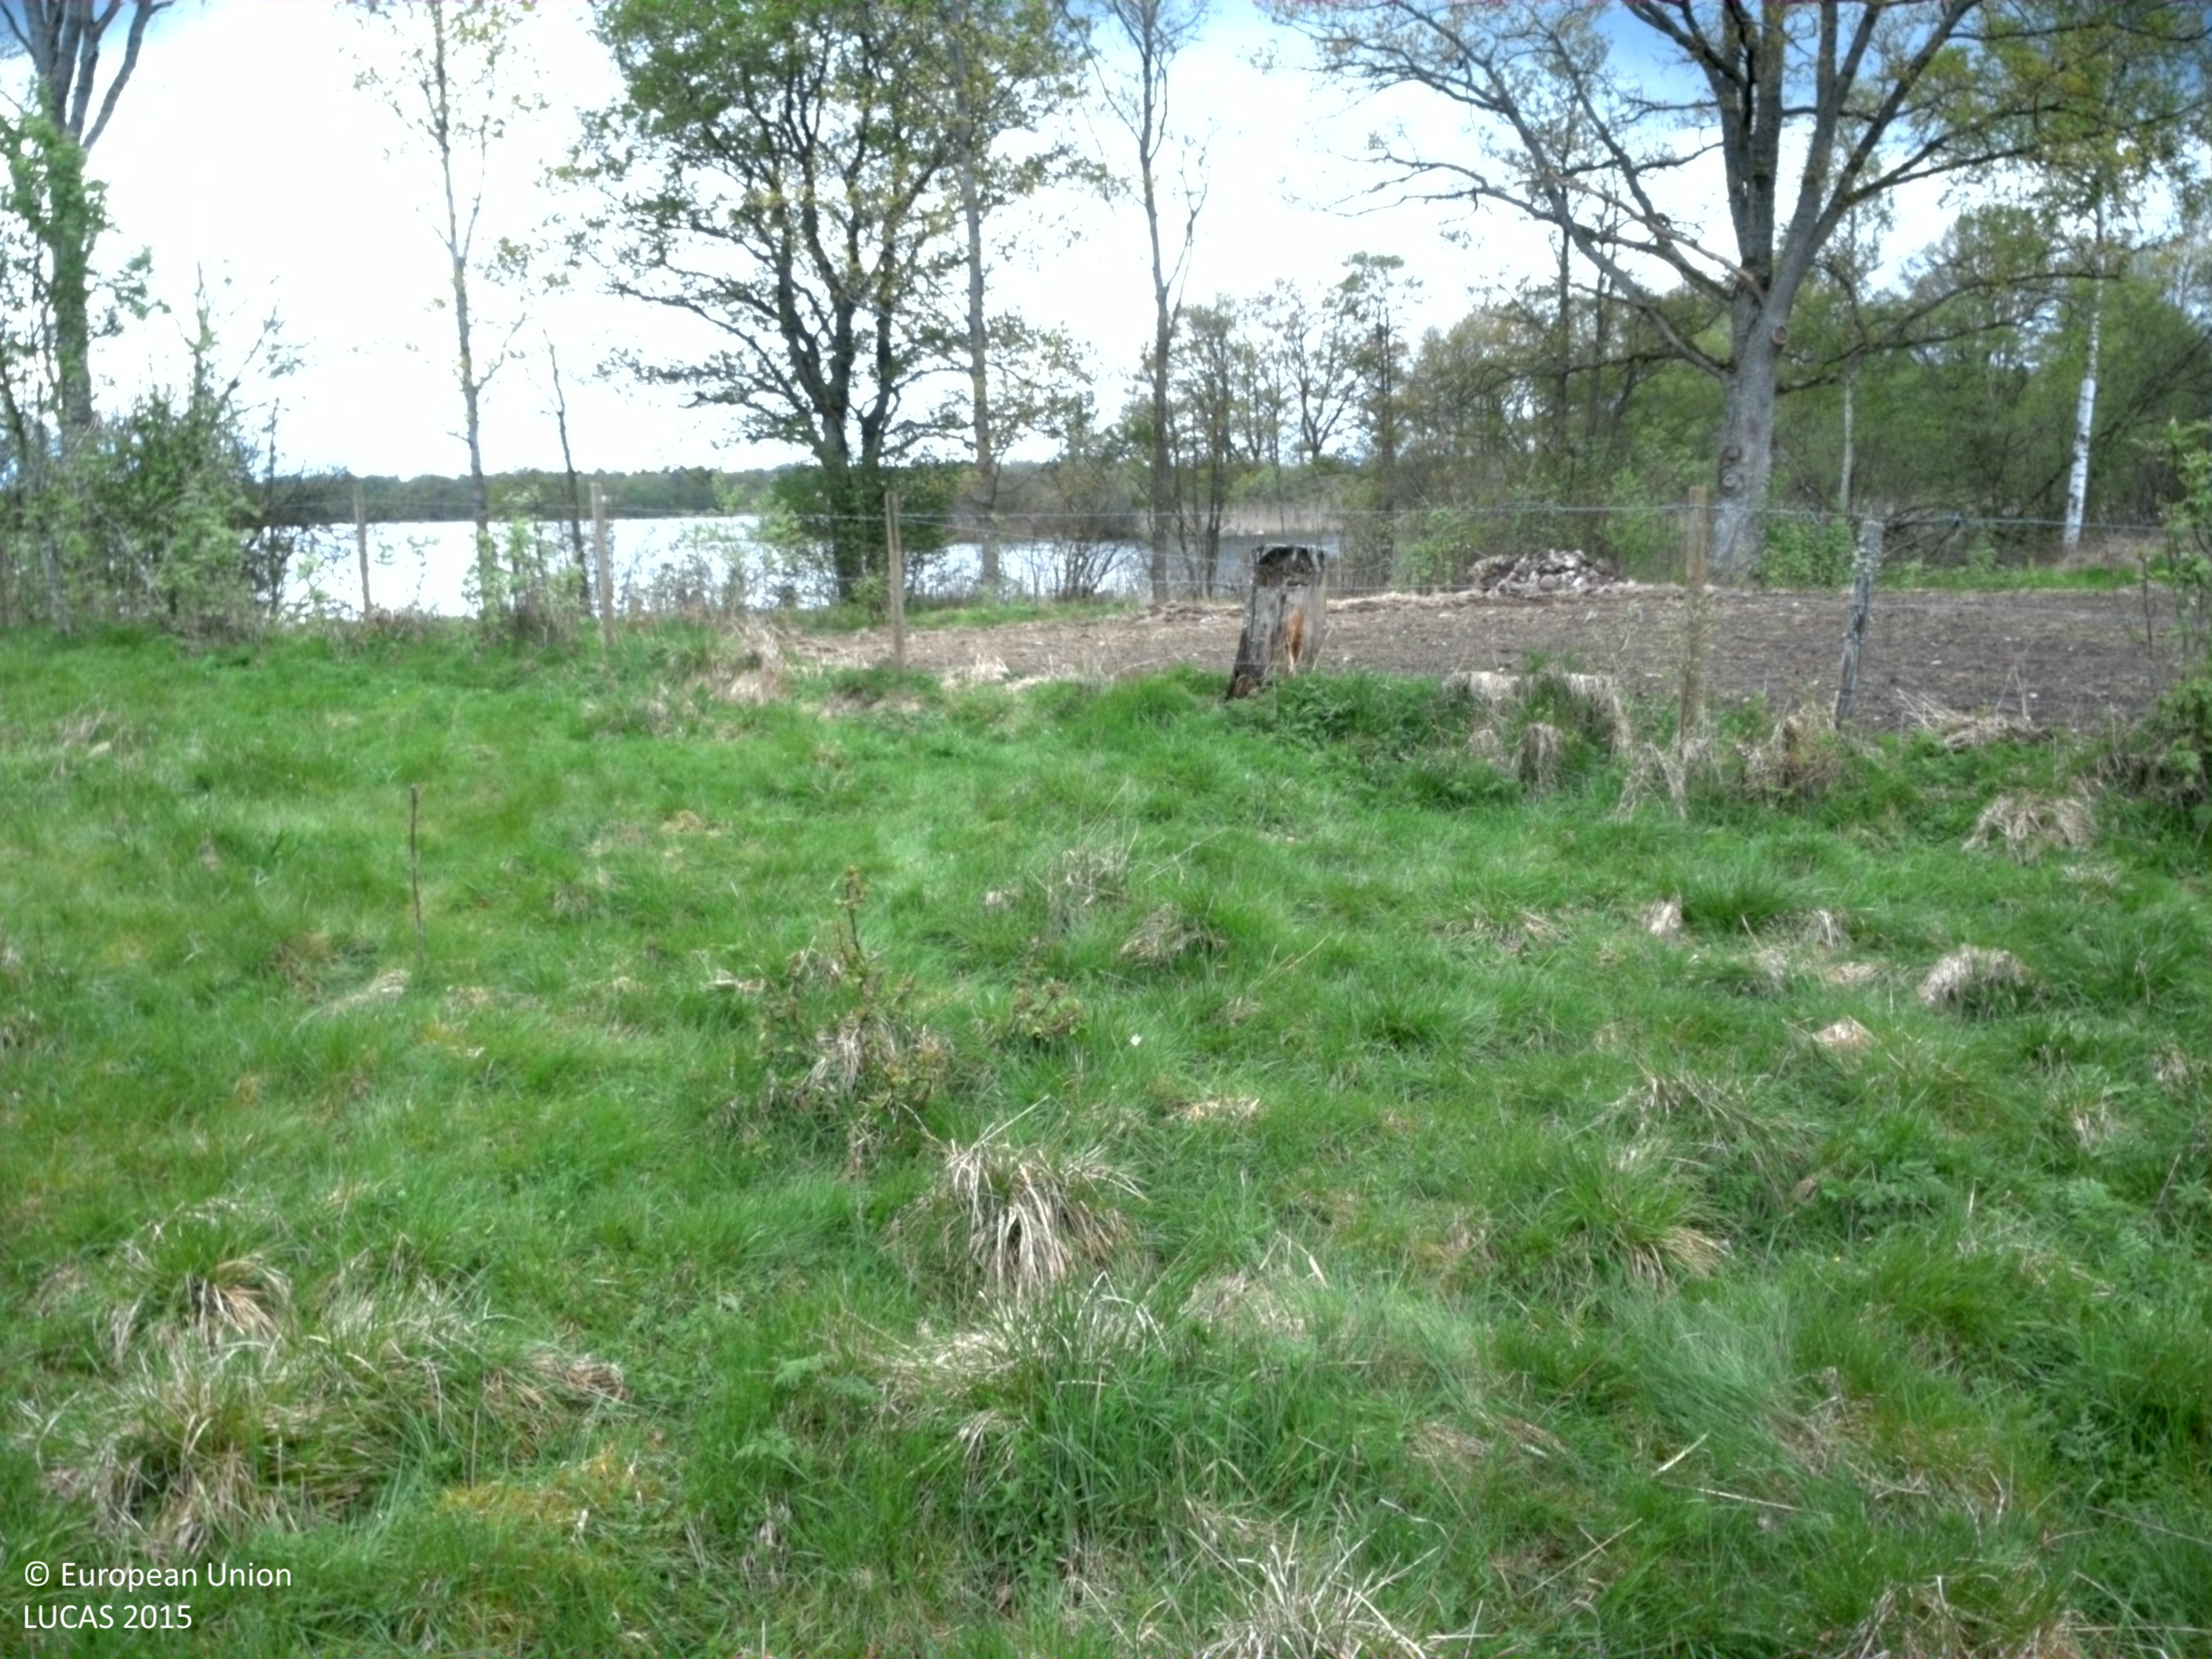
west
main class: Grassland
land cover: Grassland with sparse tree/shrub cover
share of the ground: > 75 %
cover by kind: herbaceous plants 90 %, coniferous forest trees 5 %, lichens and mosses 5 %
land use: Agriculture (excluding fallow land and kitchen gardens)
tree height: < 5 m
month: May
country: SE
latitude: 56.7135
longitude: 14.7188
